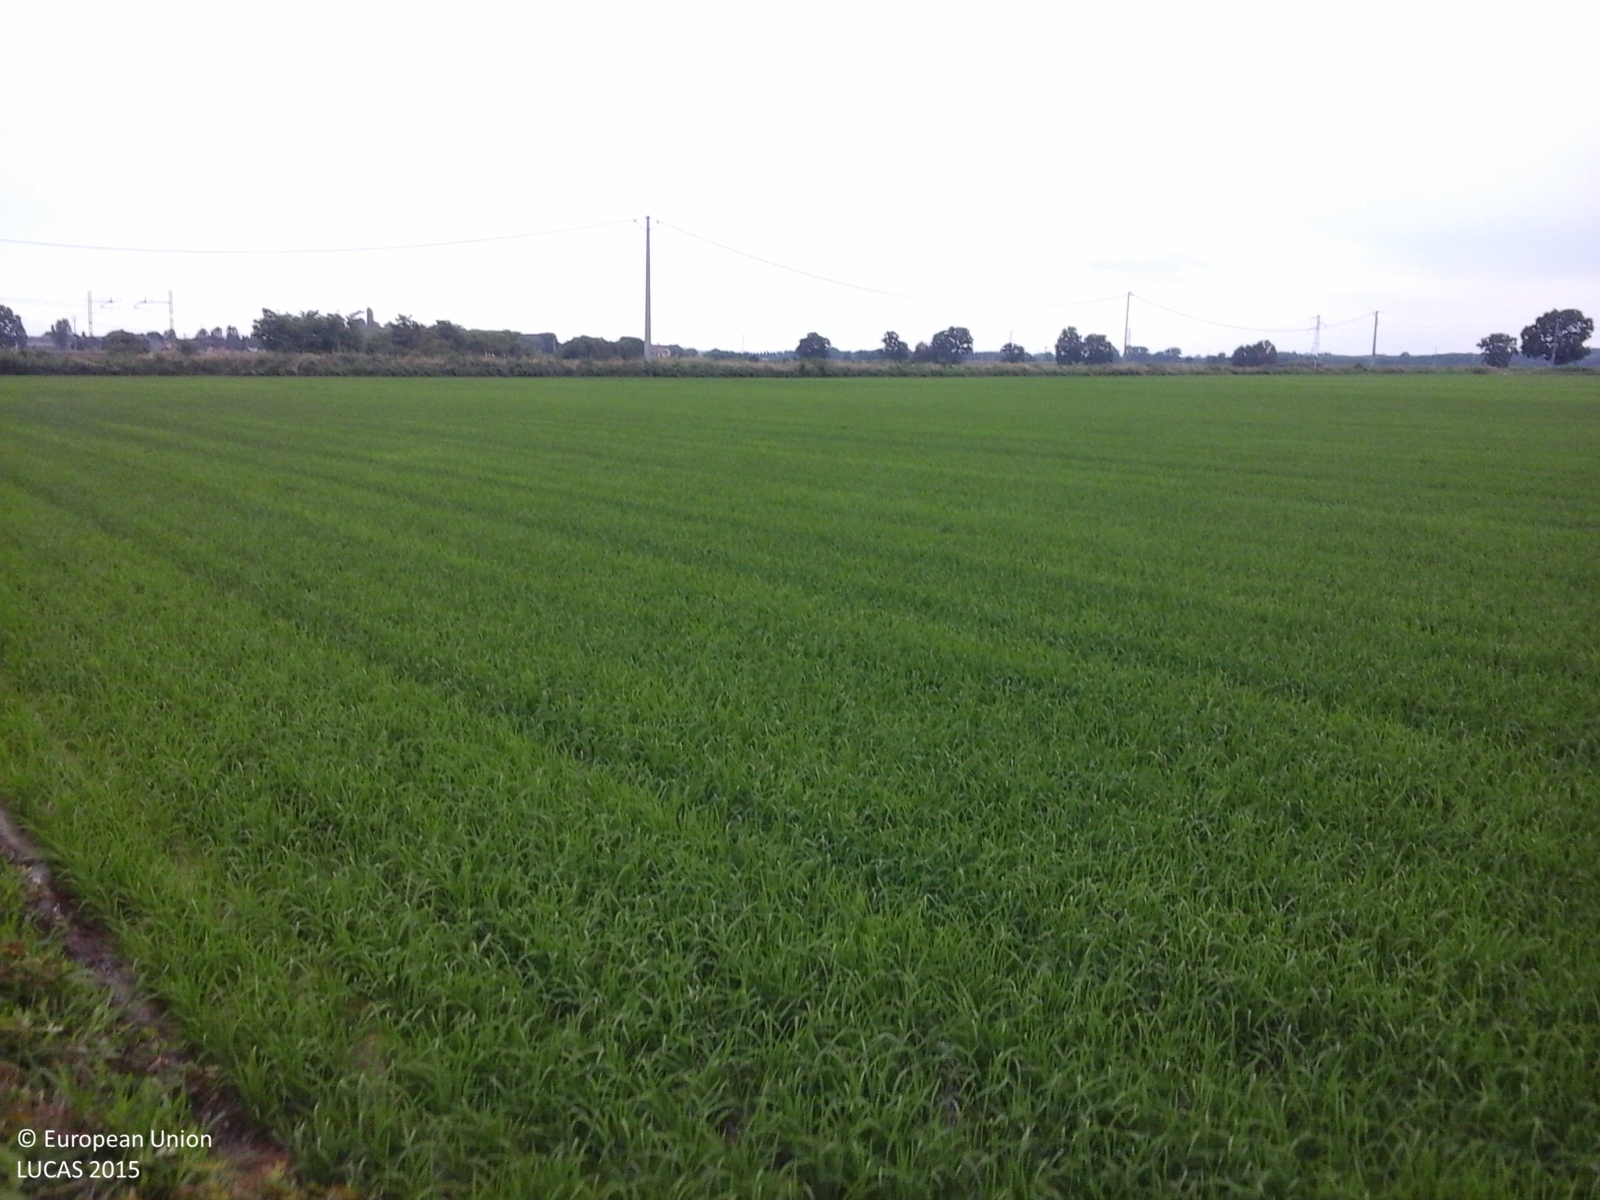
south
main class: Cropland
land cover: Rice
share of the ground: > 75 %
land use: Agriculture (excluding fallow land and kitchen gardens)
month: June
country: IT
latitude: 45.2262
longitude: 8.7160
